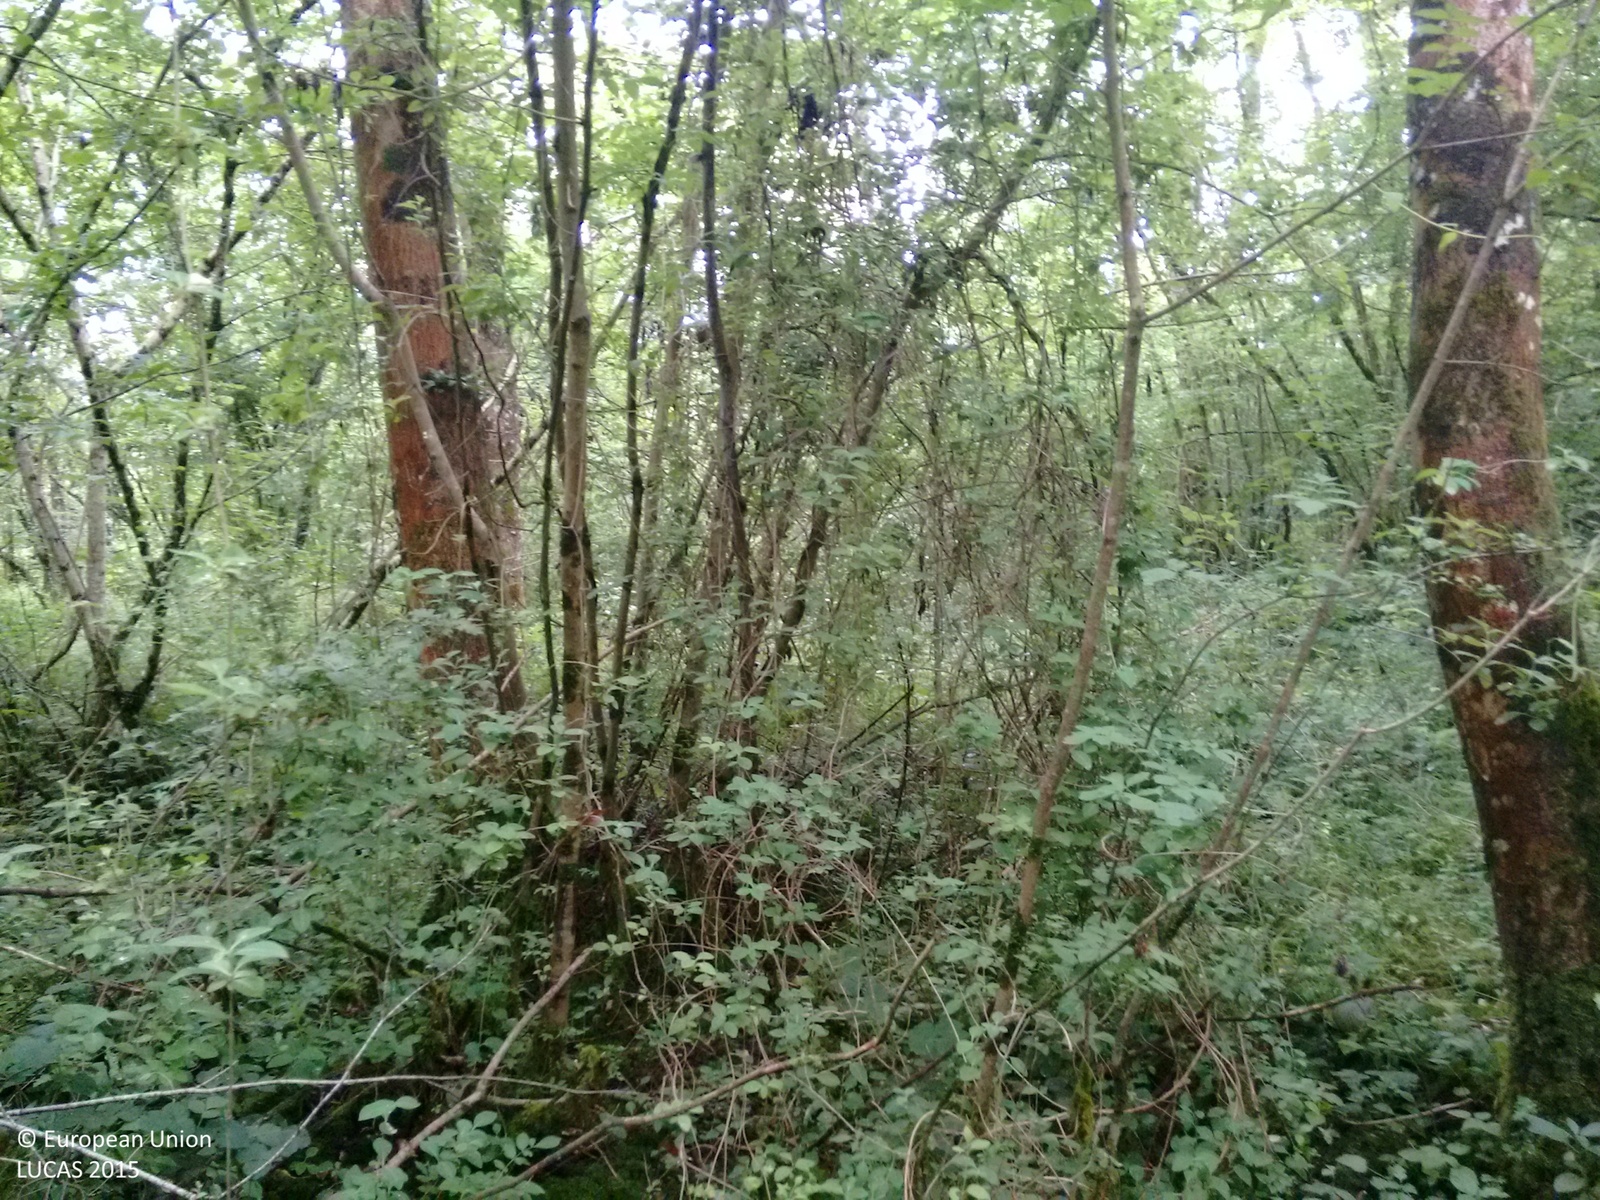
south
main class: Woodland
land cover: Broadleaved woodland
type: mesophytic deciduous forest
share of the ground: > 75 %
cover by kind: broadleaved forest trees 100 %
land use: Semi-natural and natural areas not in use
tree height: > 5 m
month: June
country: GB
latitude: 51.2364
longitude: -2.3675
